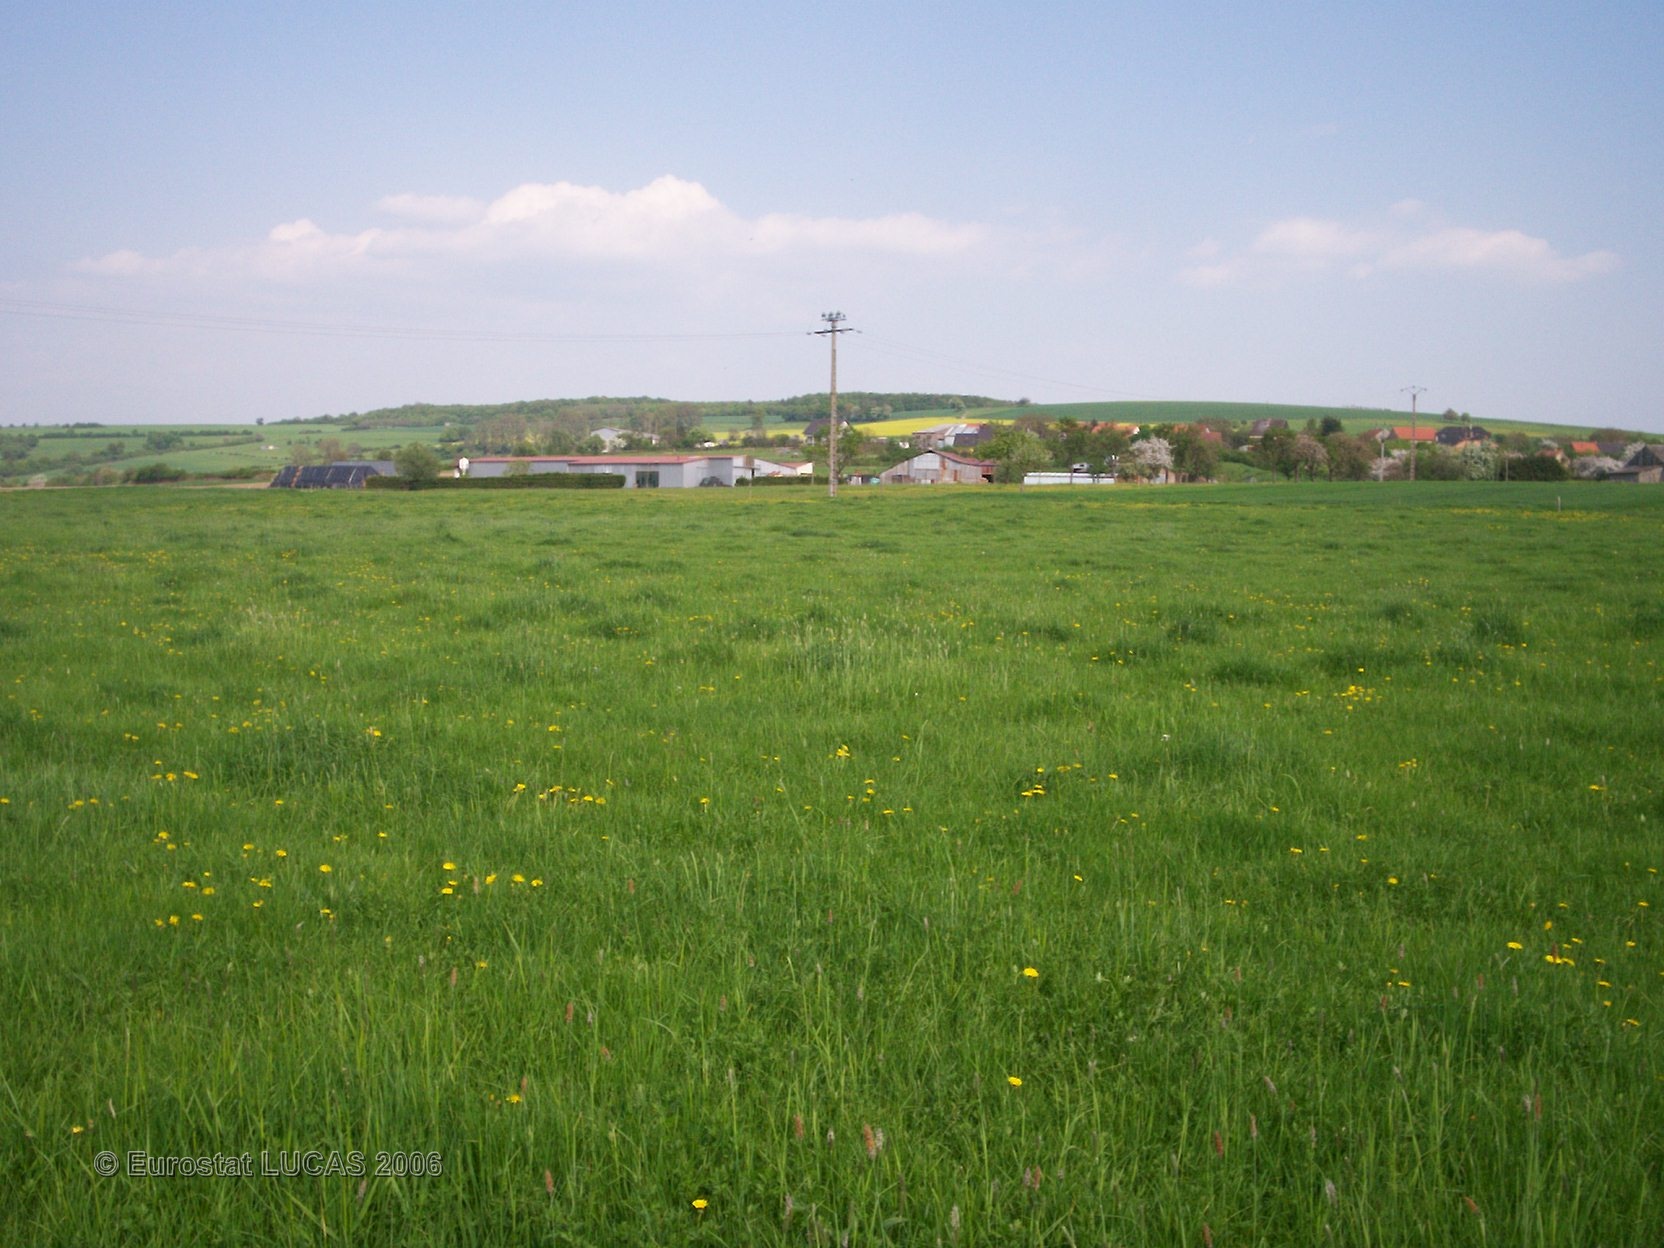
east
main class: Grassland
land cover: Grassland without tree/shrub cover
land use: Agriculture (excluding fallow land and kitchen gardens)
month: May
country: FR
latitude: 48.9047
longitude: 7.0673
